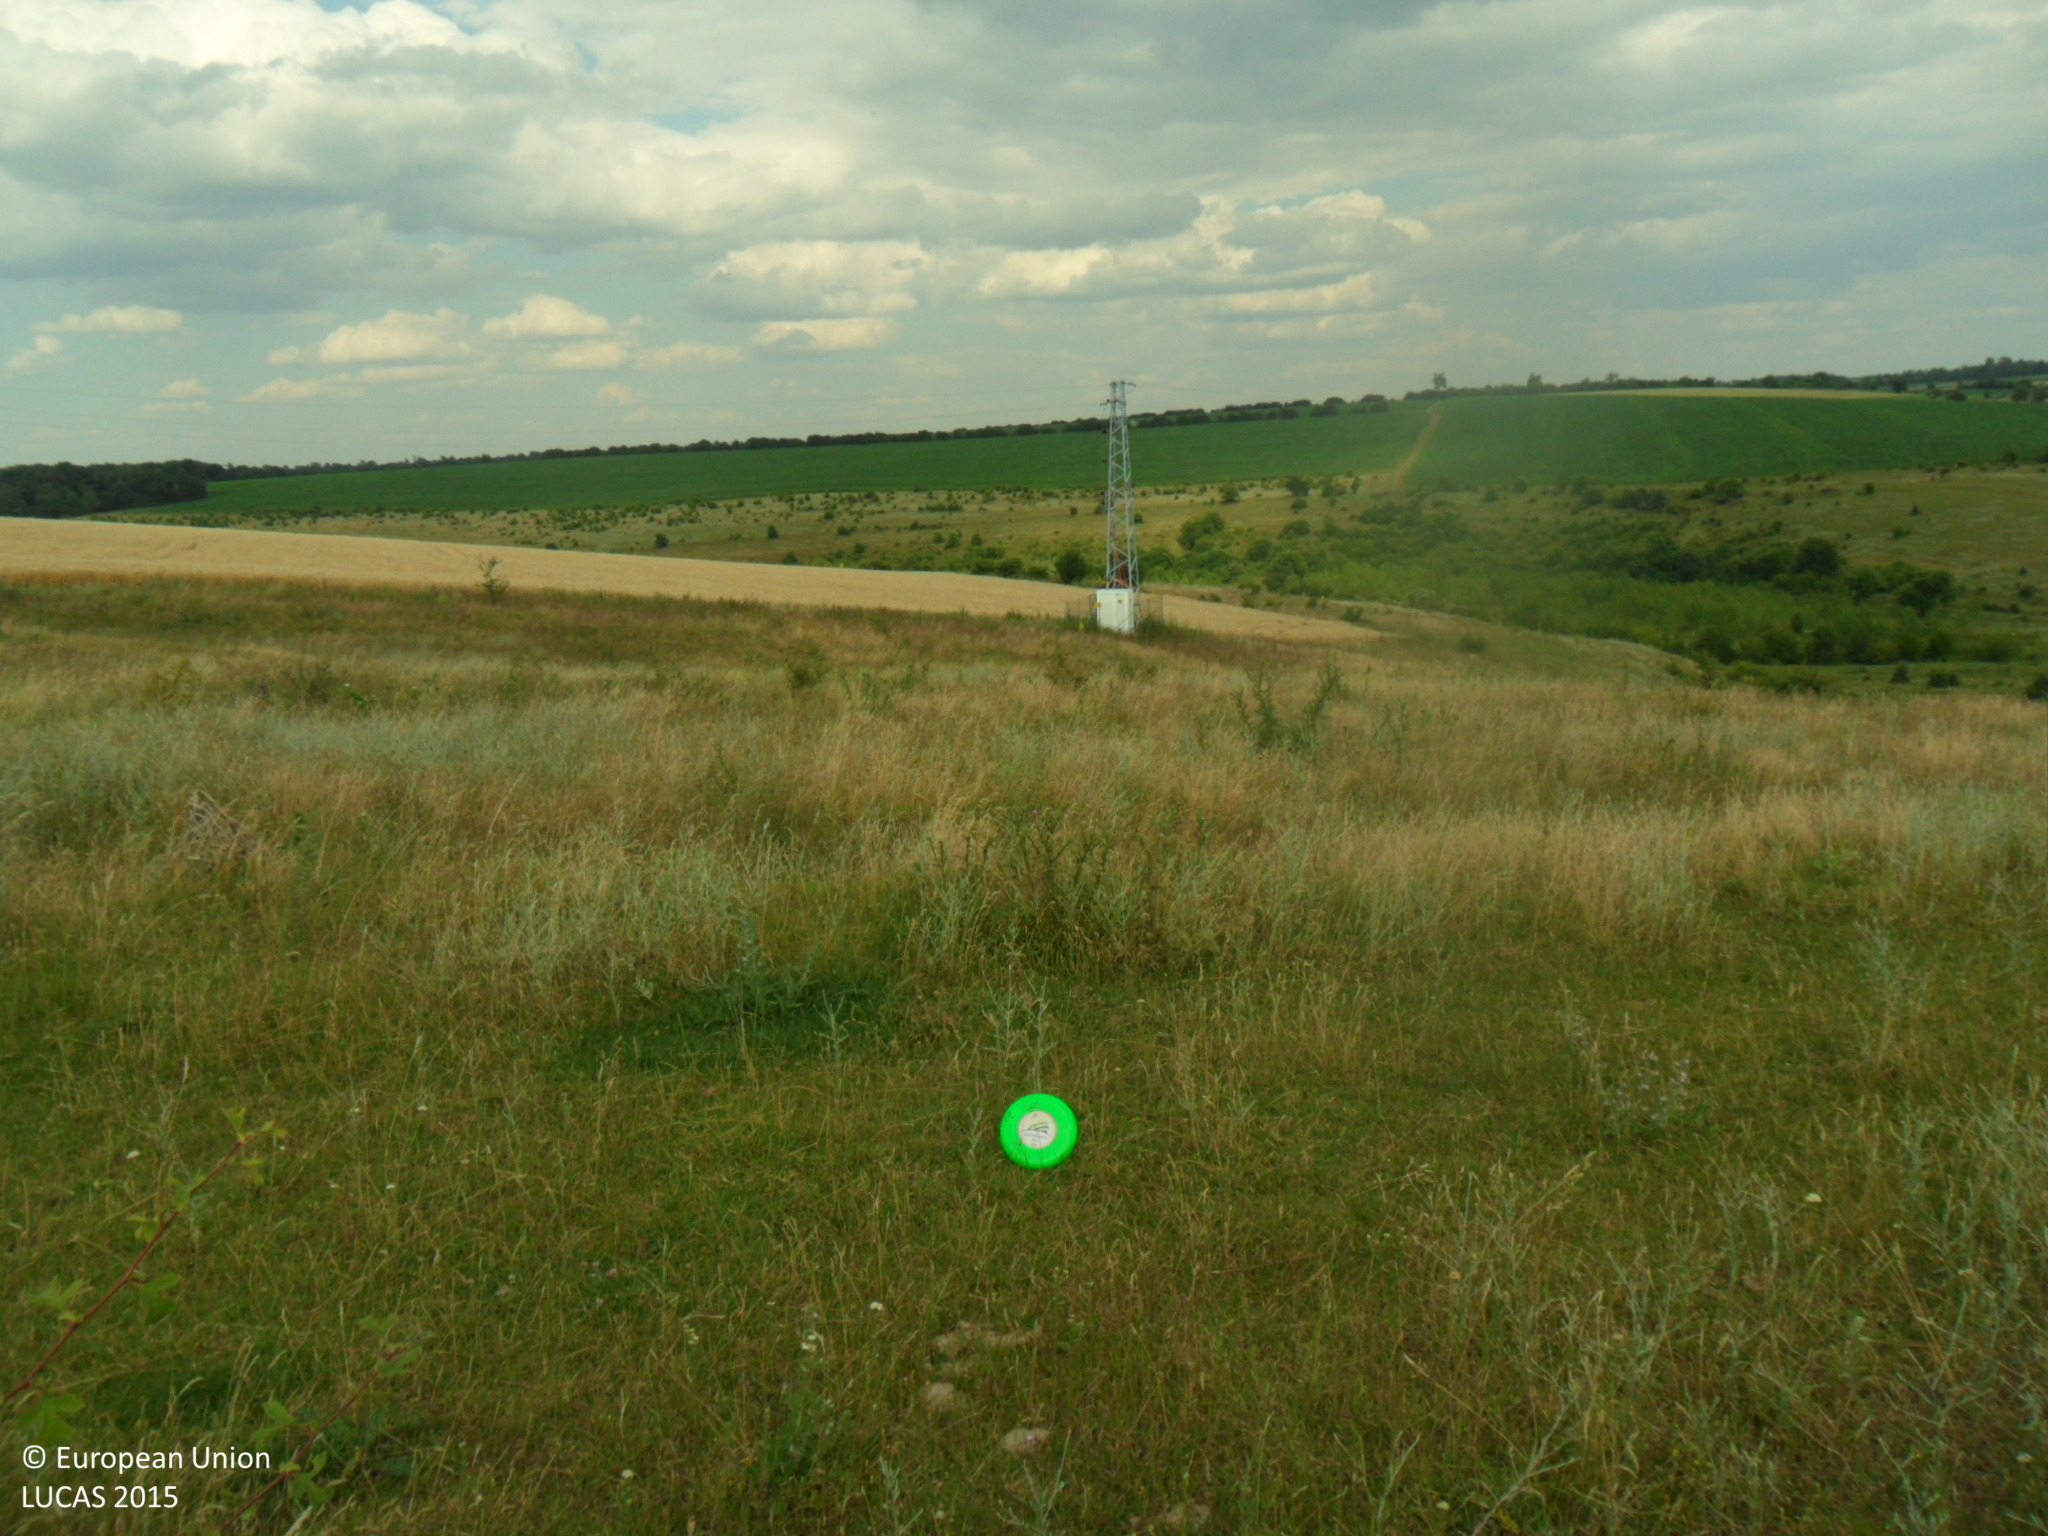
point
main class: Grassland
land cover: Grassland without tree/shrub cover
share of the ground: > 75 %
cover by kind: herbaceous plants 100 %
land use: Agriculture (excluding fallow land and kitchen gardens)
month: June
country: BG
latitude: 43.5875
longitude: 26.6183
